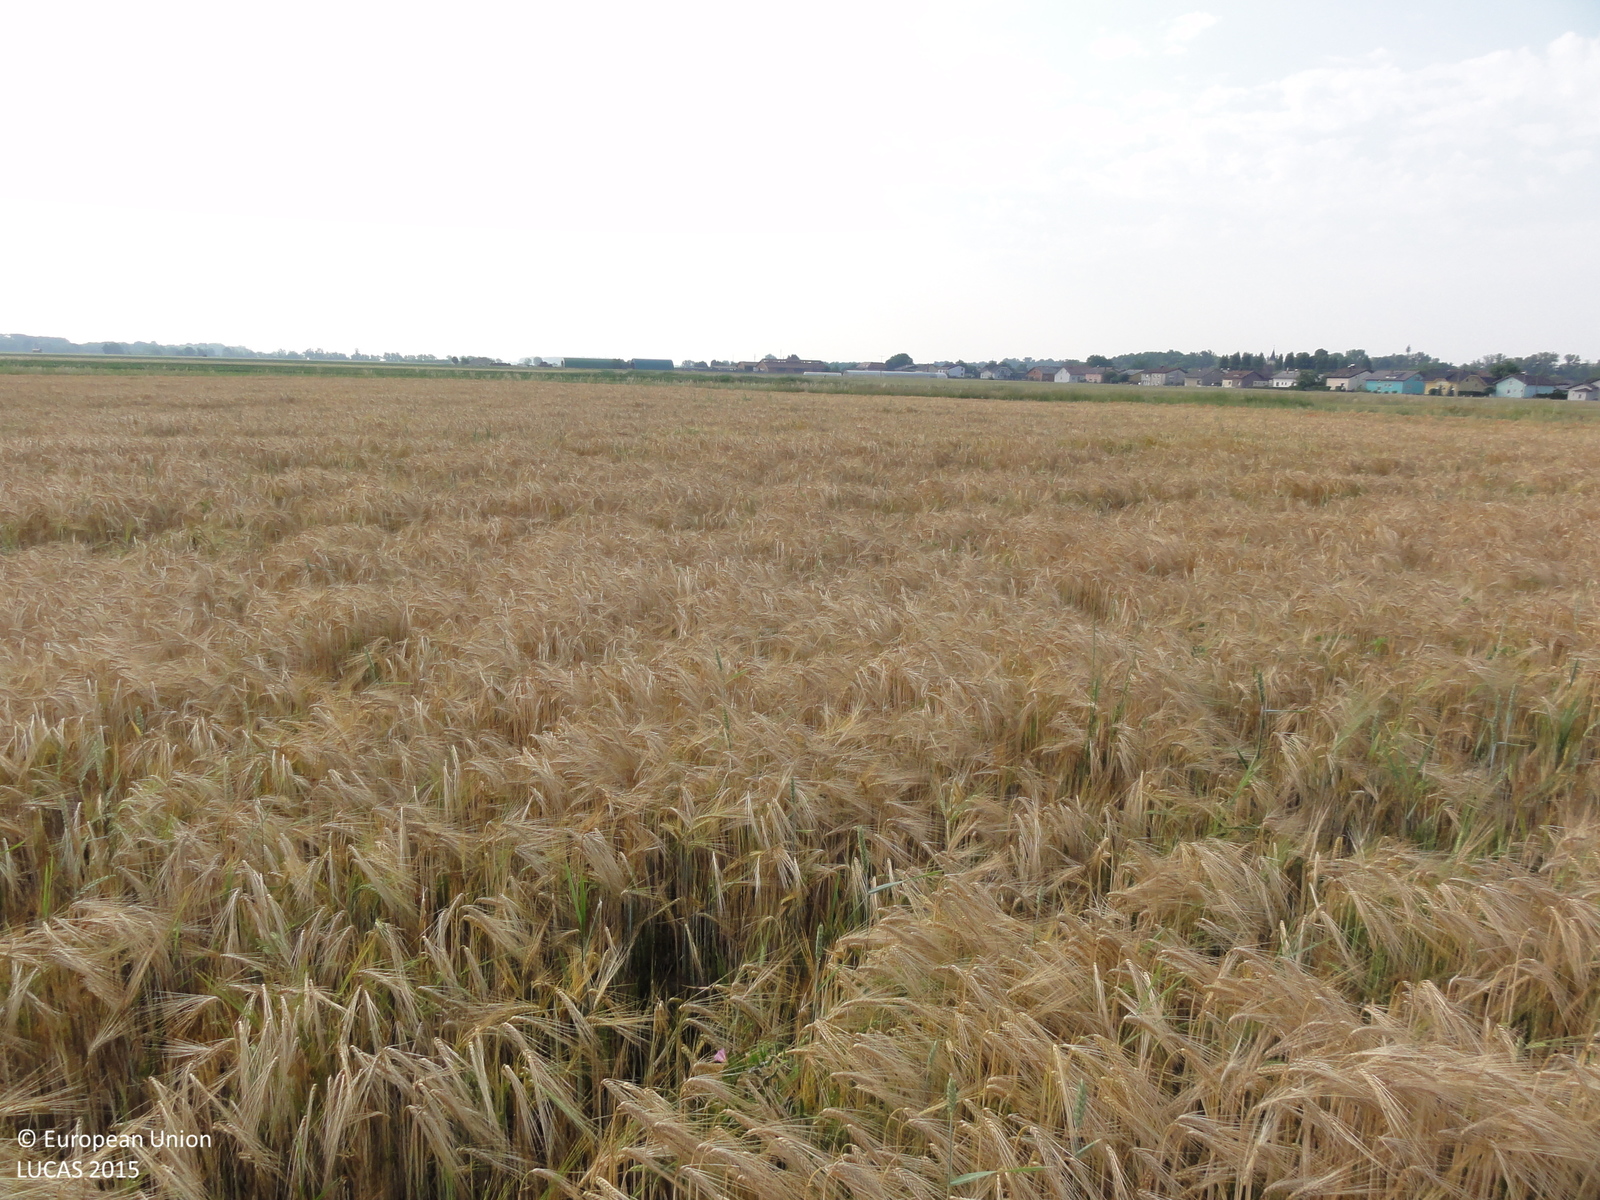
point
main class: Cropland
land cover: Barley
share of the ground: > 75 %
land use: Agriculture (excluding fallow land and kitchen gardens)
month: June
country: SI
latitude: 46.6062
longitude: 16.1758
